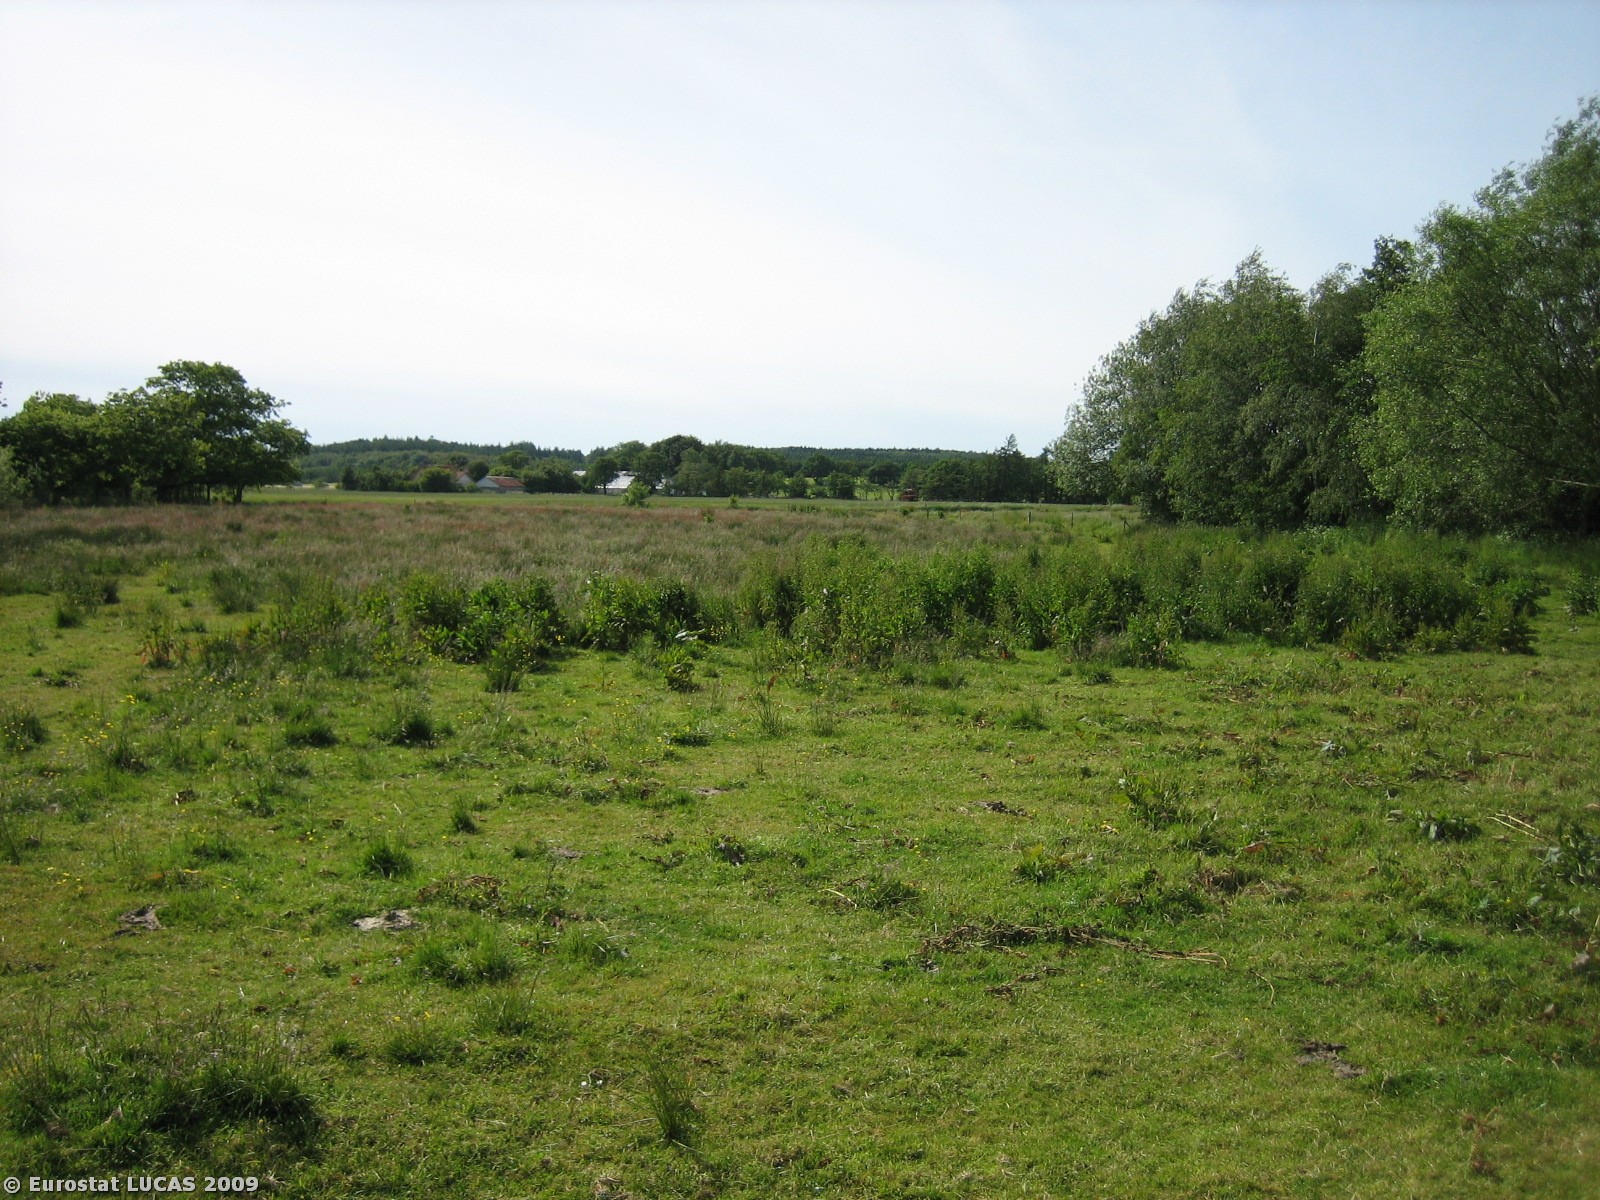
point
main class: Cropland
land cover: Common wheat
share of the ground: > 75 %
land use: Agriculture (excluding fallow land and kitchen gardens)
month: June
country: DK
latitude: 55.7545
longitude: 9.3156
